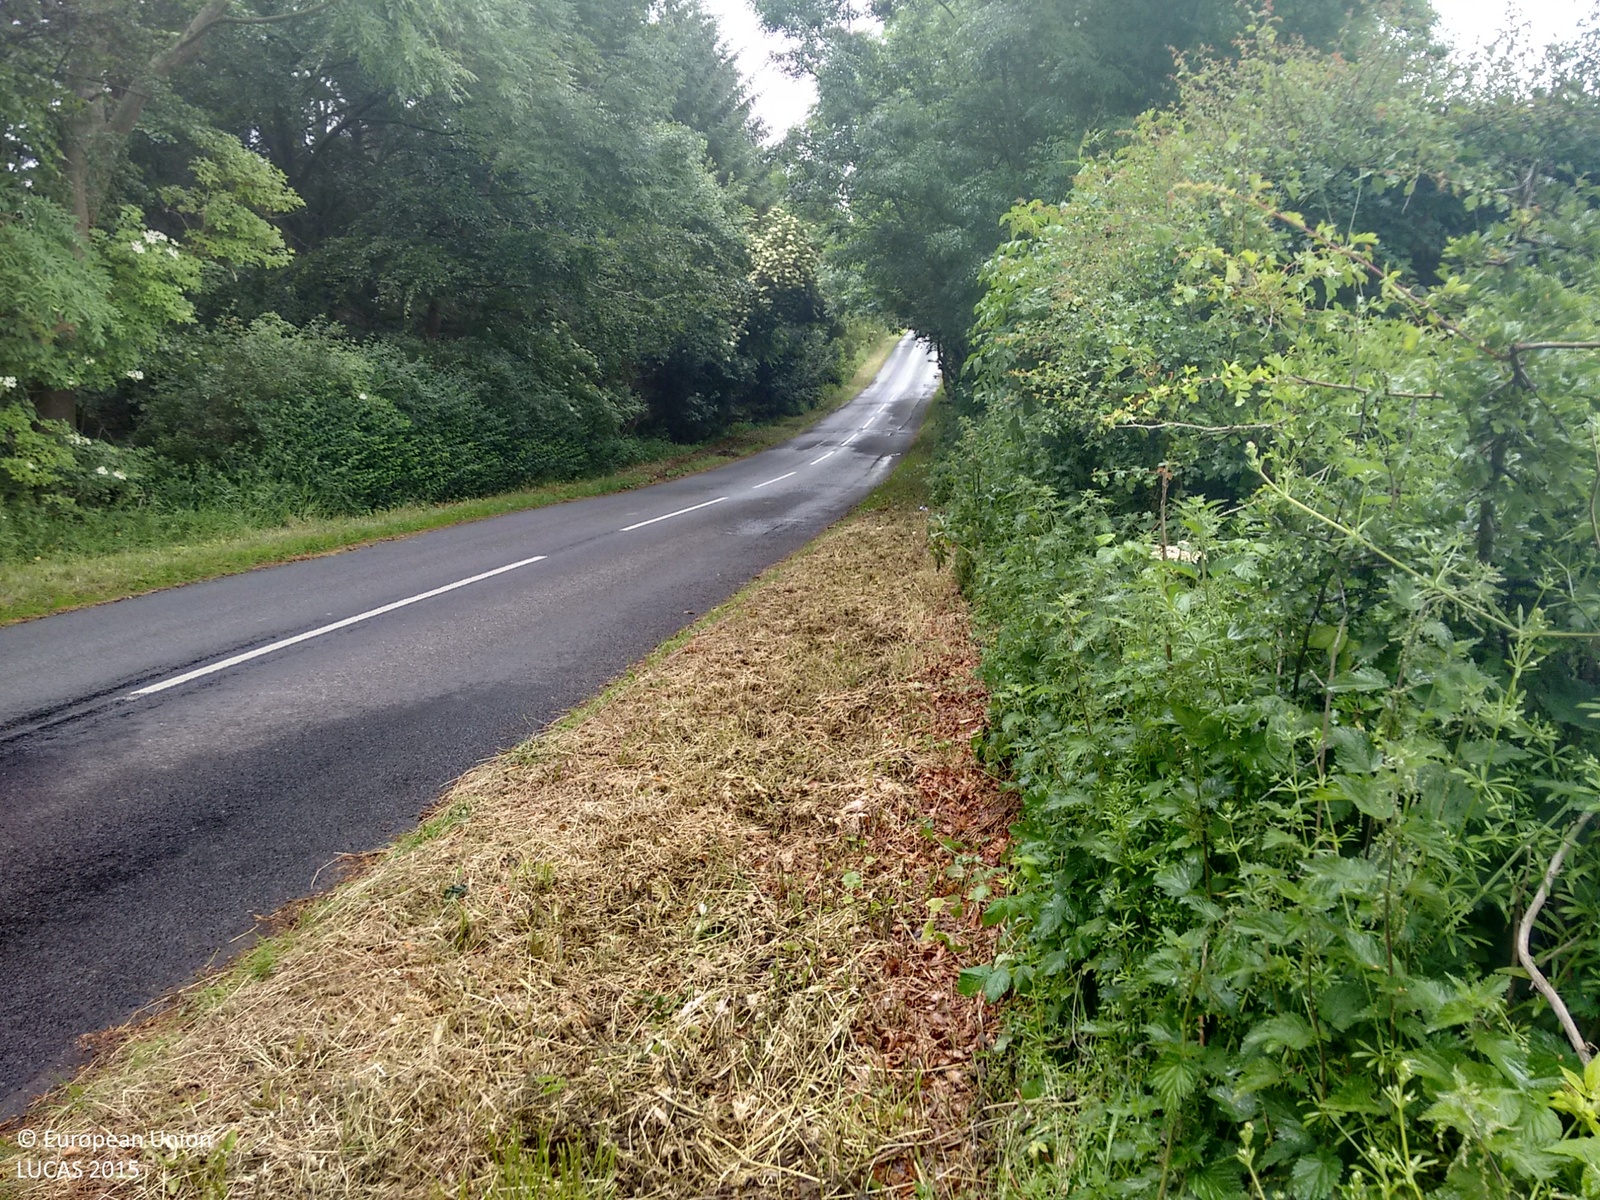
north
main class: Grassland
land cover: Grassland without tree/shrub cover
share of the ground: > 75 %
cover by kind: herbaceous plants 100 %
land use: Agriculture (excluding fallow land and kitchen gardens)
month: July
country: GB
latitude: 54.6159
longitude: -1.8688
